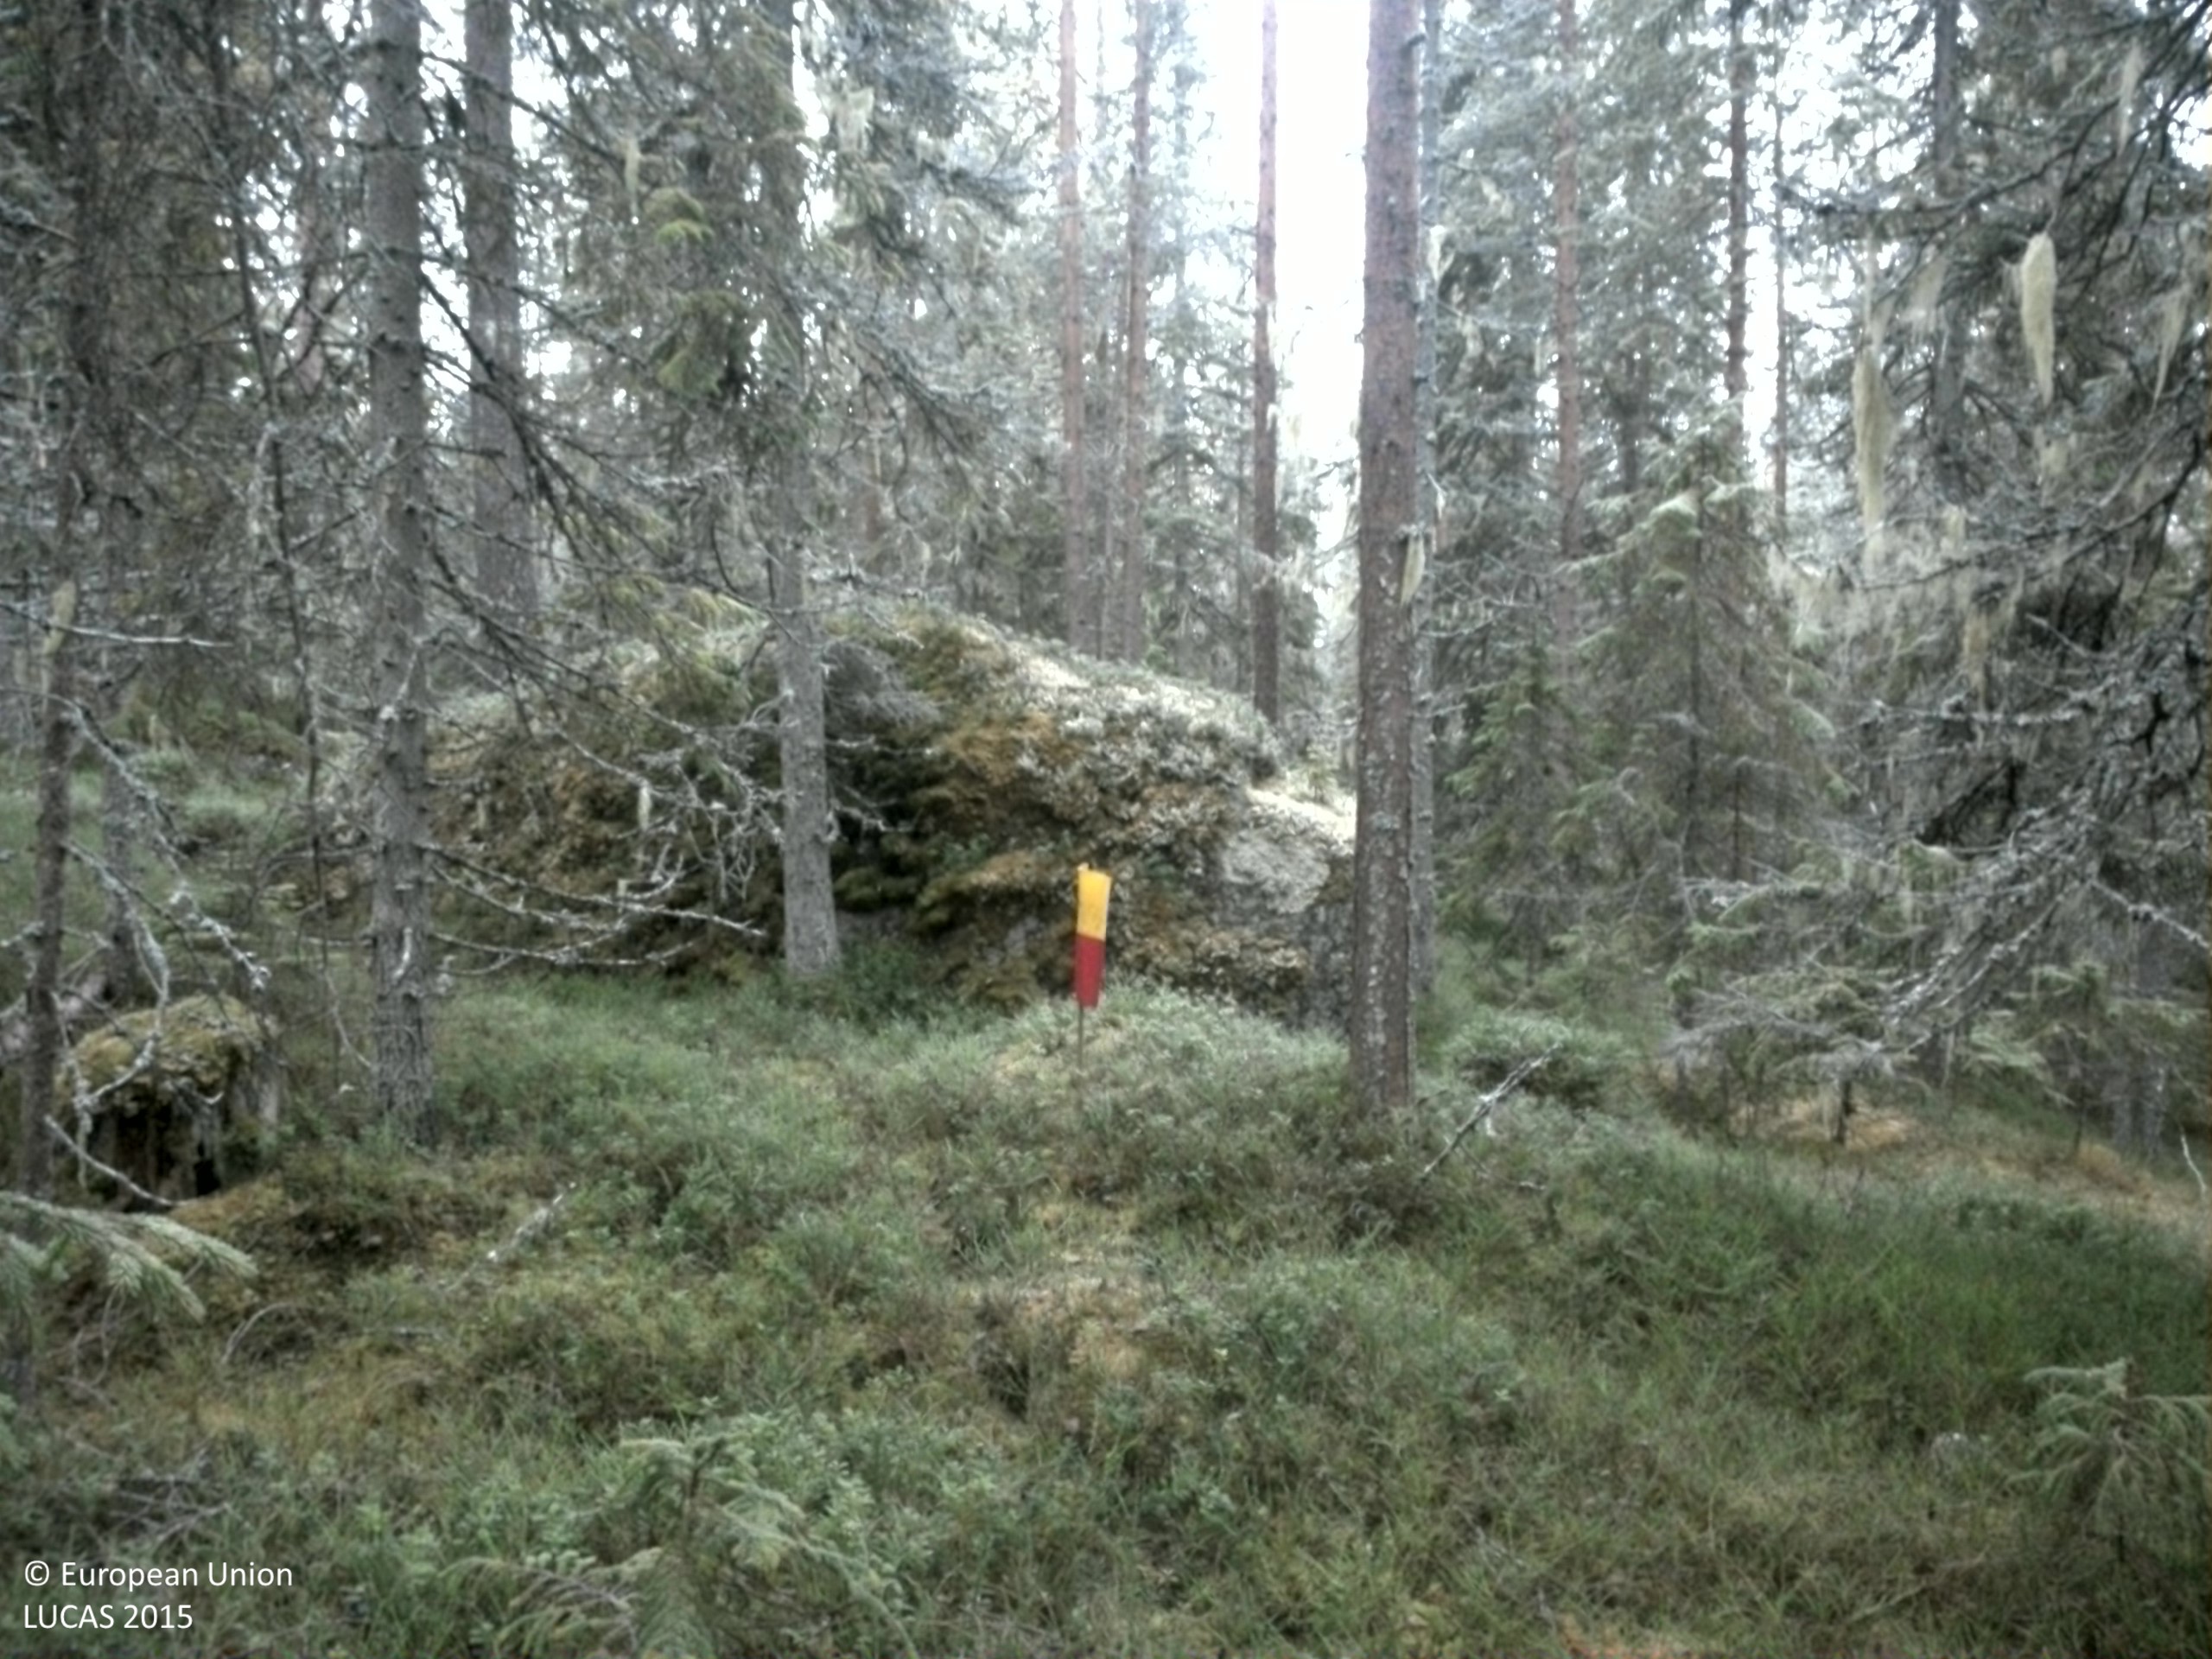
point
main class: Woodland
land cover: Other coniferous woodland
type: boreal forest
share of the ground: 50 - 75 %
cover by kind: coniferous forest trees 55 %, shrubs 25 %, lichens and mosses 15 %, broadleaved forest trees 5 %
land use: Forestry
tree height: > 5 m
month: November
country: SE
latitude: 63.7853
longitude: 15.7965
